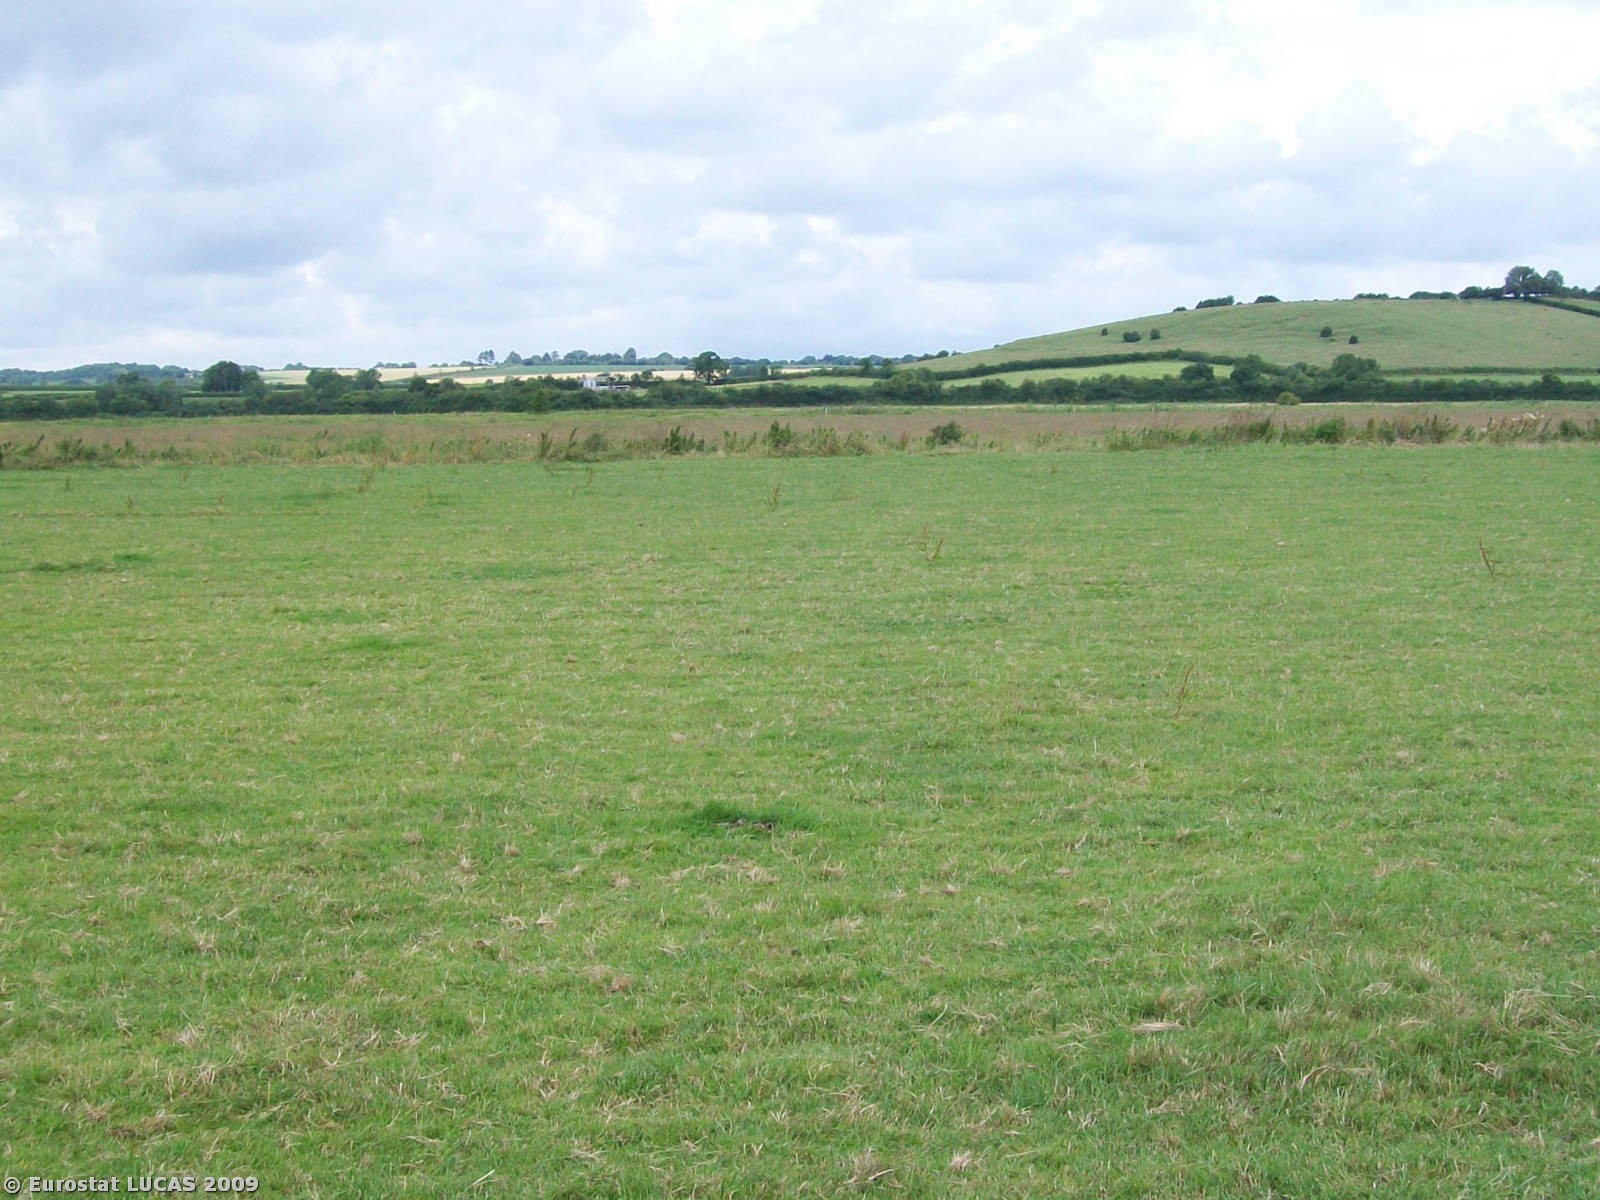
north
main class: Grassland
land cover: Grassland without tree/shrub cover
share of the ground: > 75 %
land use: Agriculture (excluding fallow land and kitchen gardens)
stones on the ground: < 10 %
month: July
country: GB
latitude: 51.0135
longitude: -2.7420
